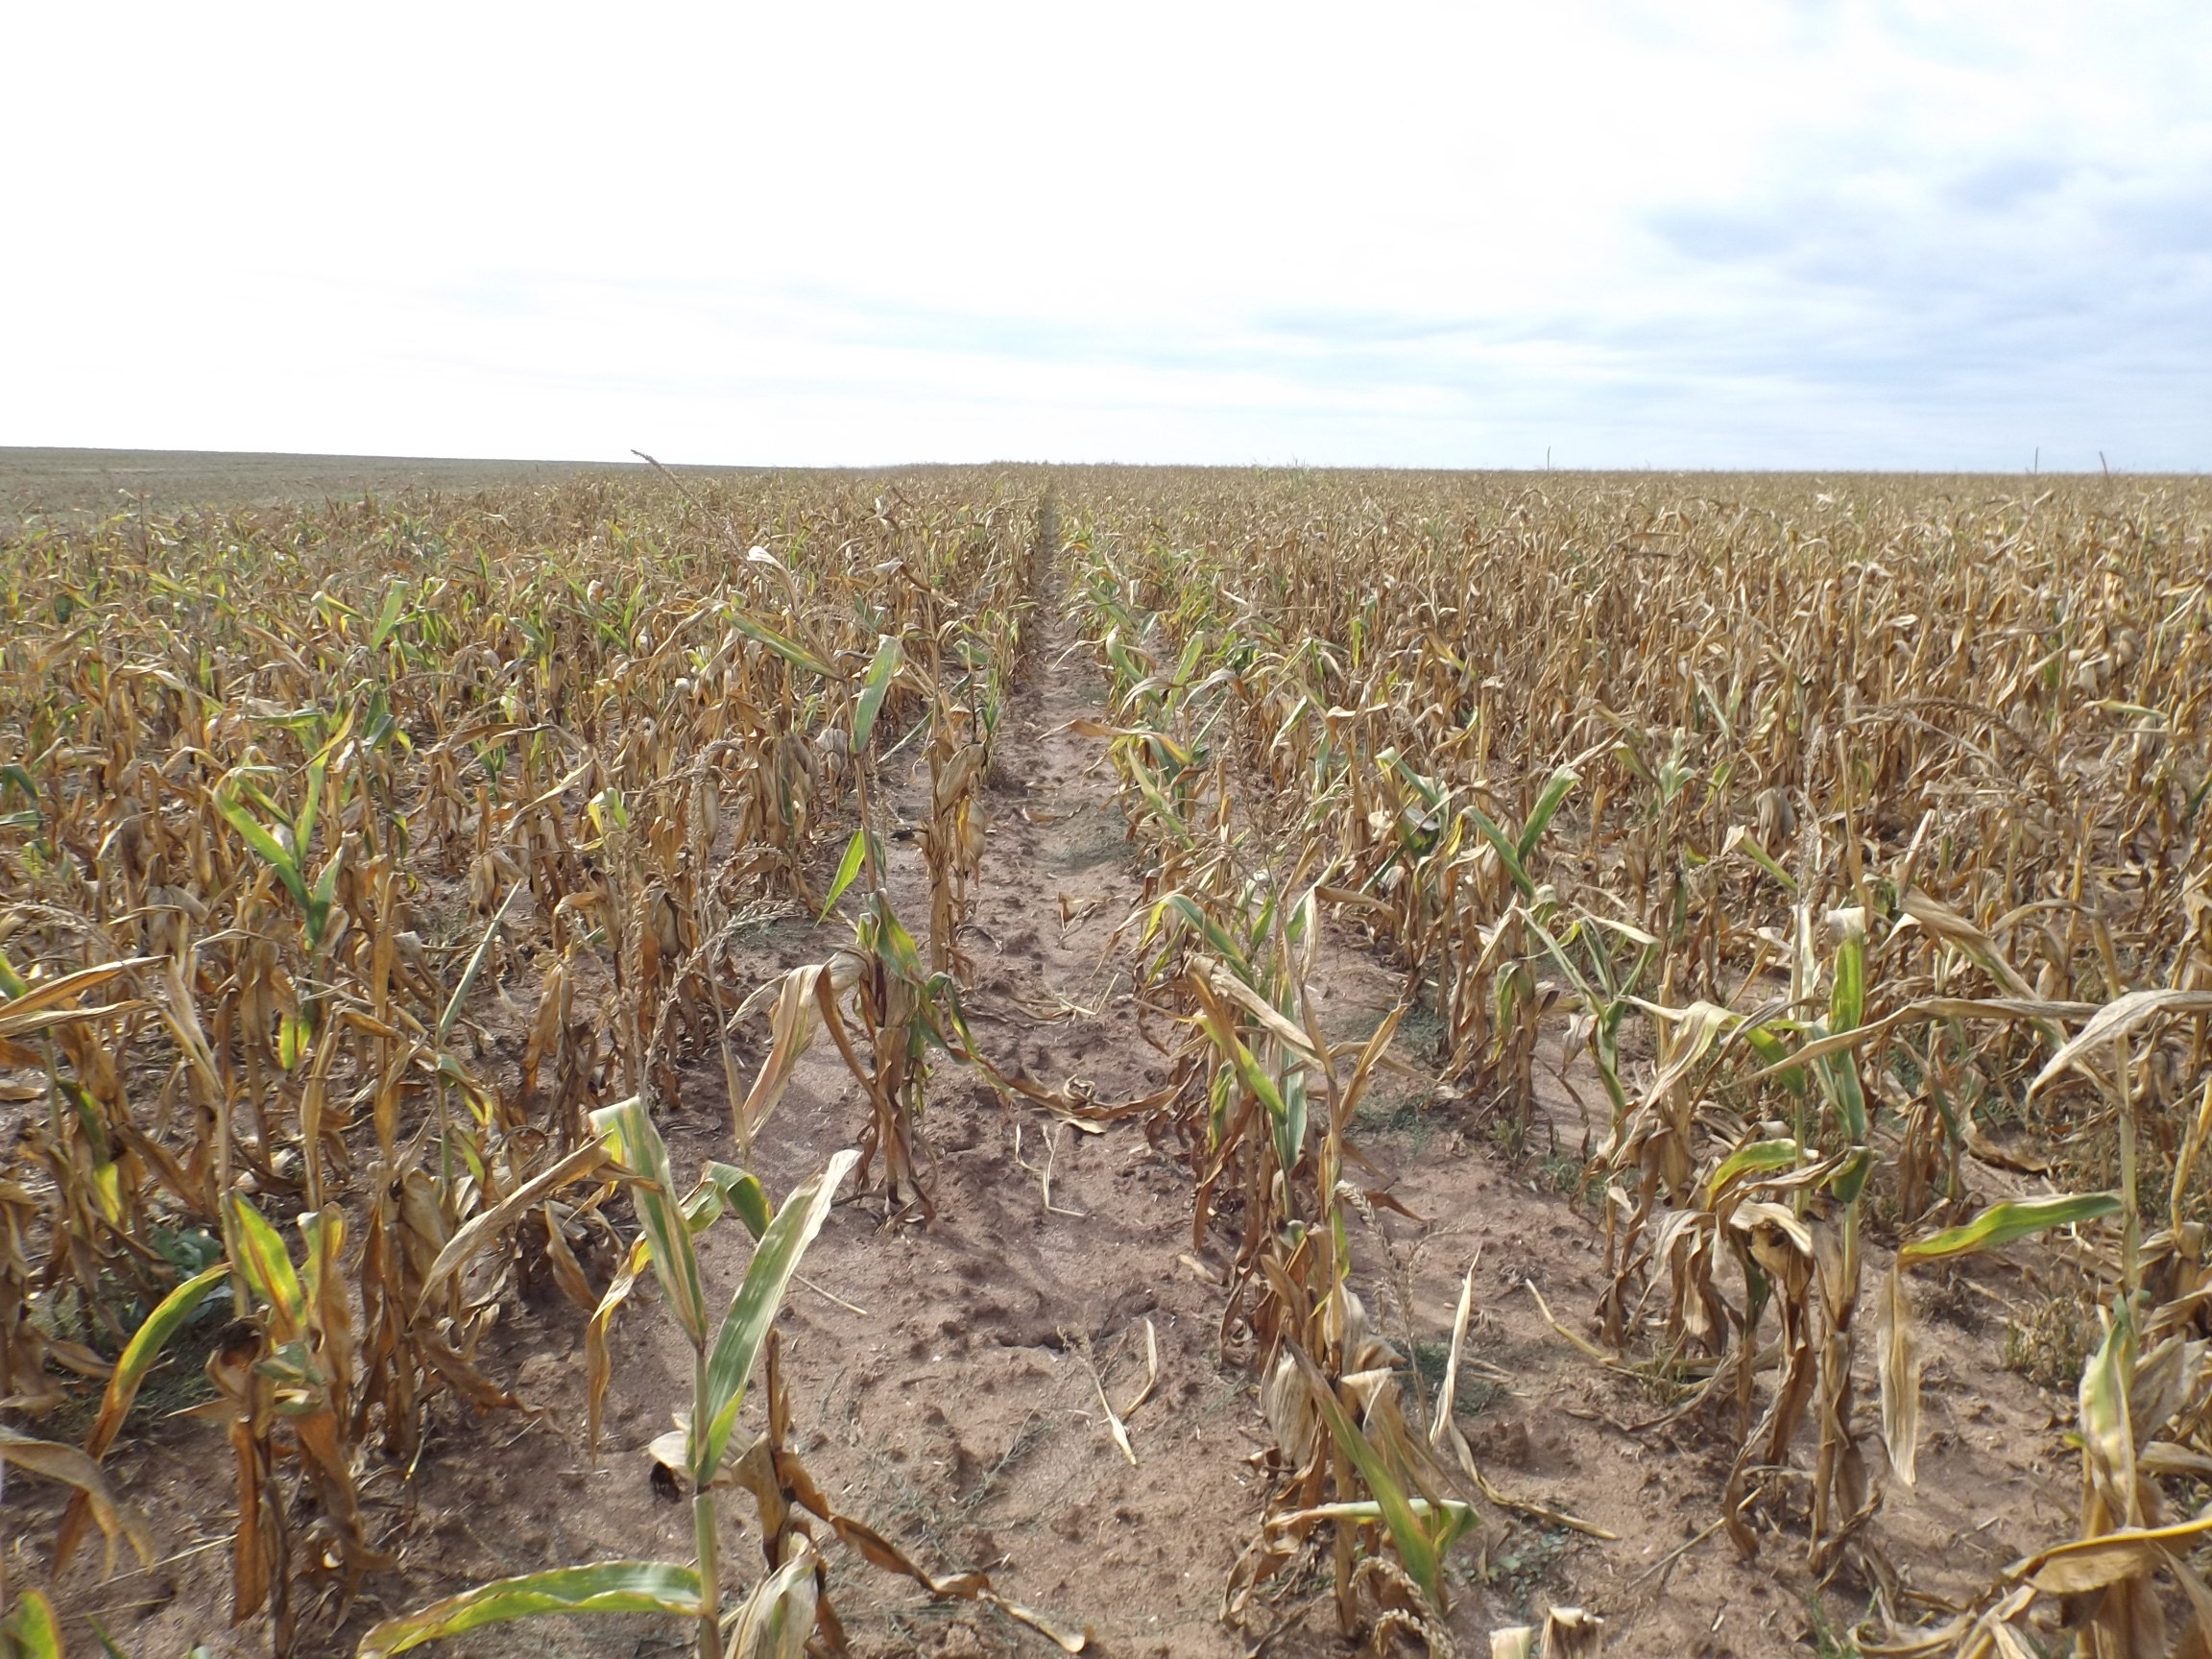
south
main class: Cropland
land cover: Maize
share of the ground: > 75 %
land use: Agriculture (excluding fallow land and kitchen gardens)
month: September
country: BG
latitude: 43.3873
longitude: 27.3714
